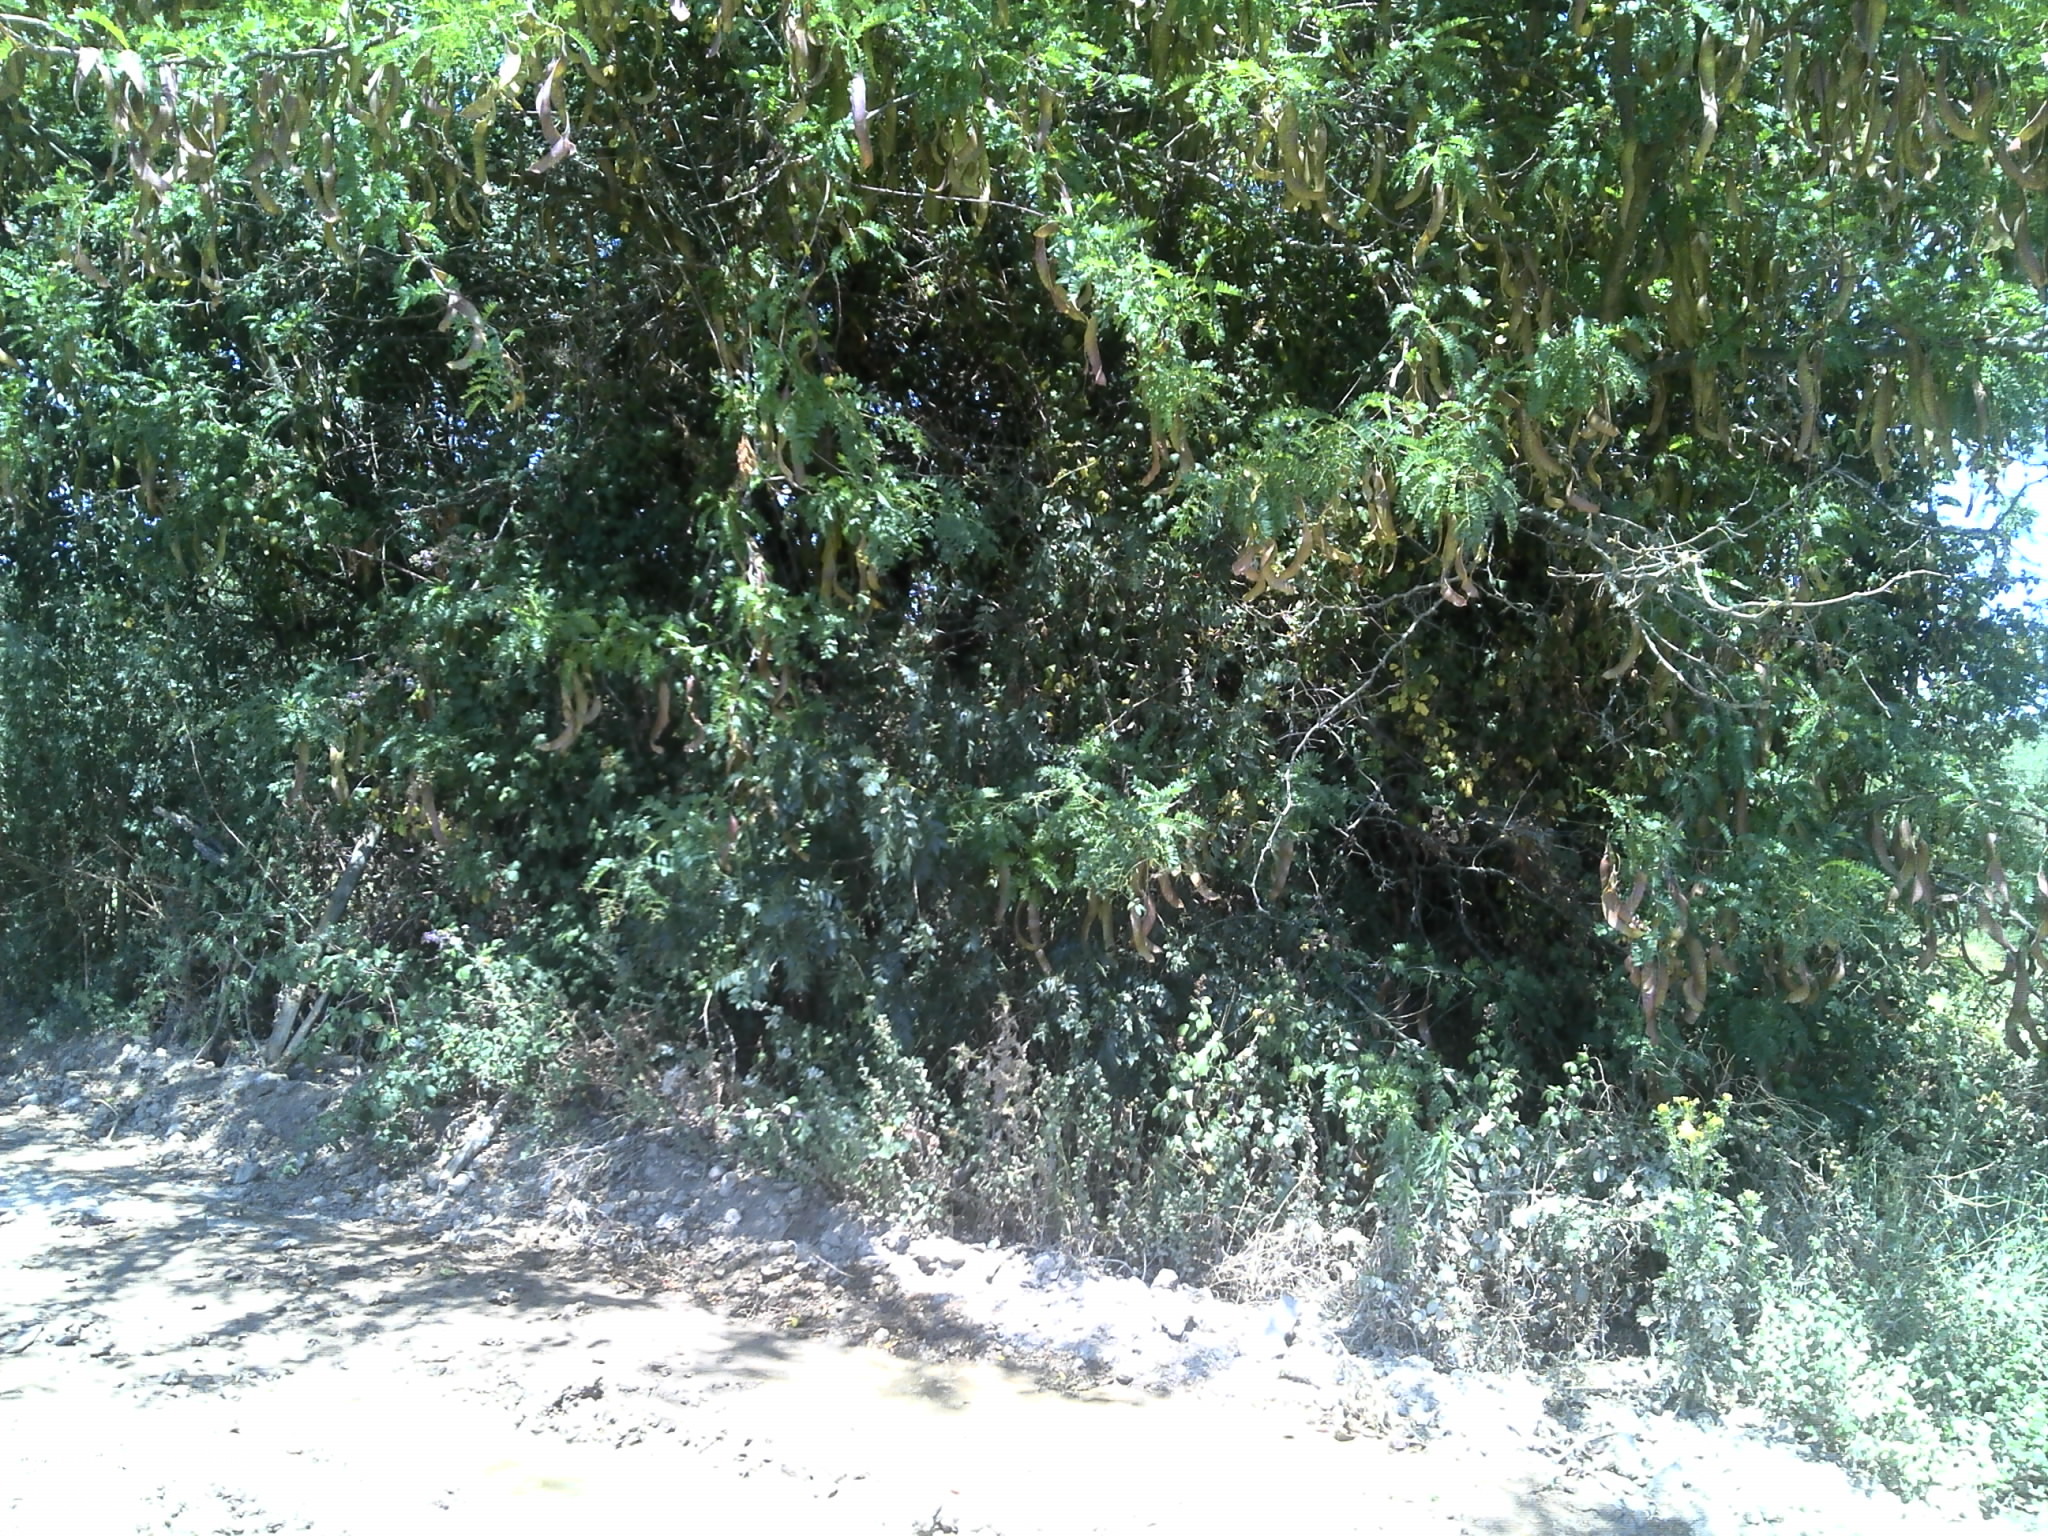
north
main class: Cropland
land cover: Tomatoes
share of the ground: > 75 %
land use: Agriculture (excluding fallow land and kitchen gardens)
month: June
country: PT
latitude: 39.1959
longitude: -8.6786
